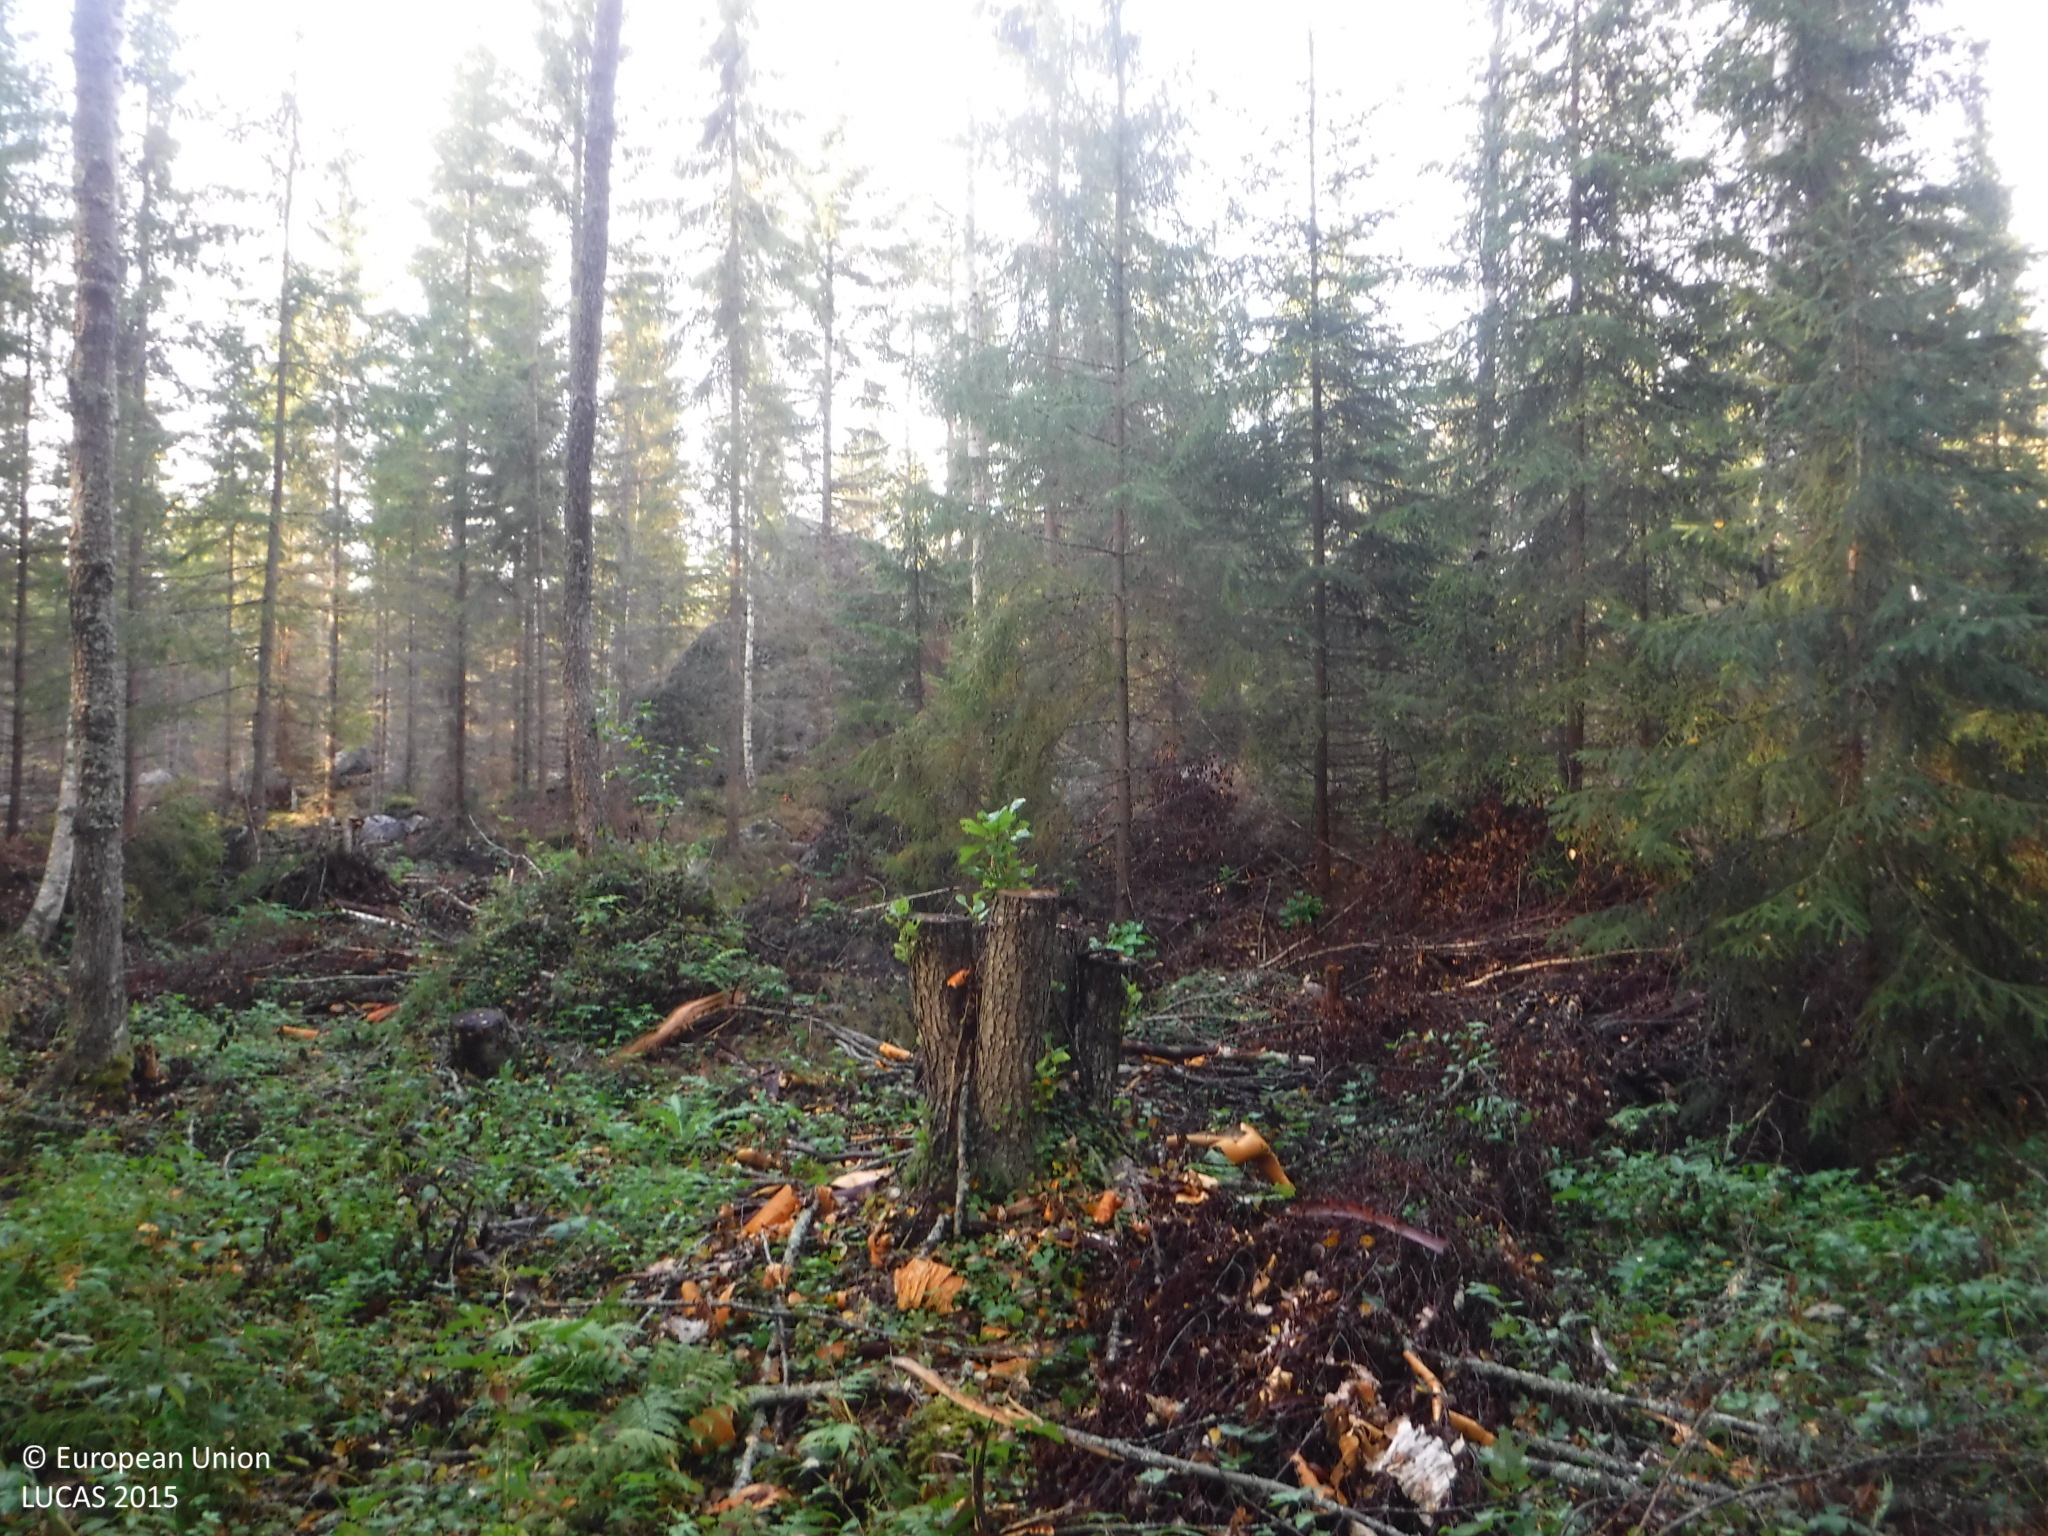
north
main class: Woodland
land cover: Spruce dominated mixed woodland
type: boreal forest
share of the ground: 50 - 75 %
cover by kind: coniferous forest trees 35 %, herbaceous plants 35 %, broadleaved forest trees 20 %, shrubs 10 %
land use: Forestry
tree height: > 5 m
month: September
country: FI
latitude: 61.7205
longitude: 21.6491
